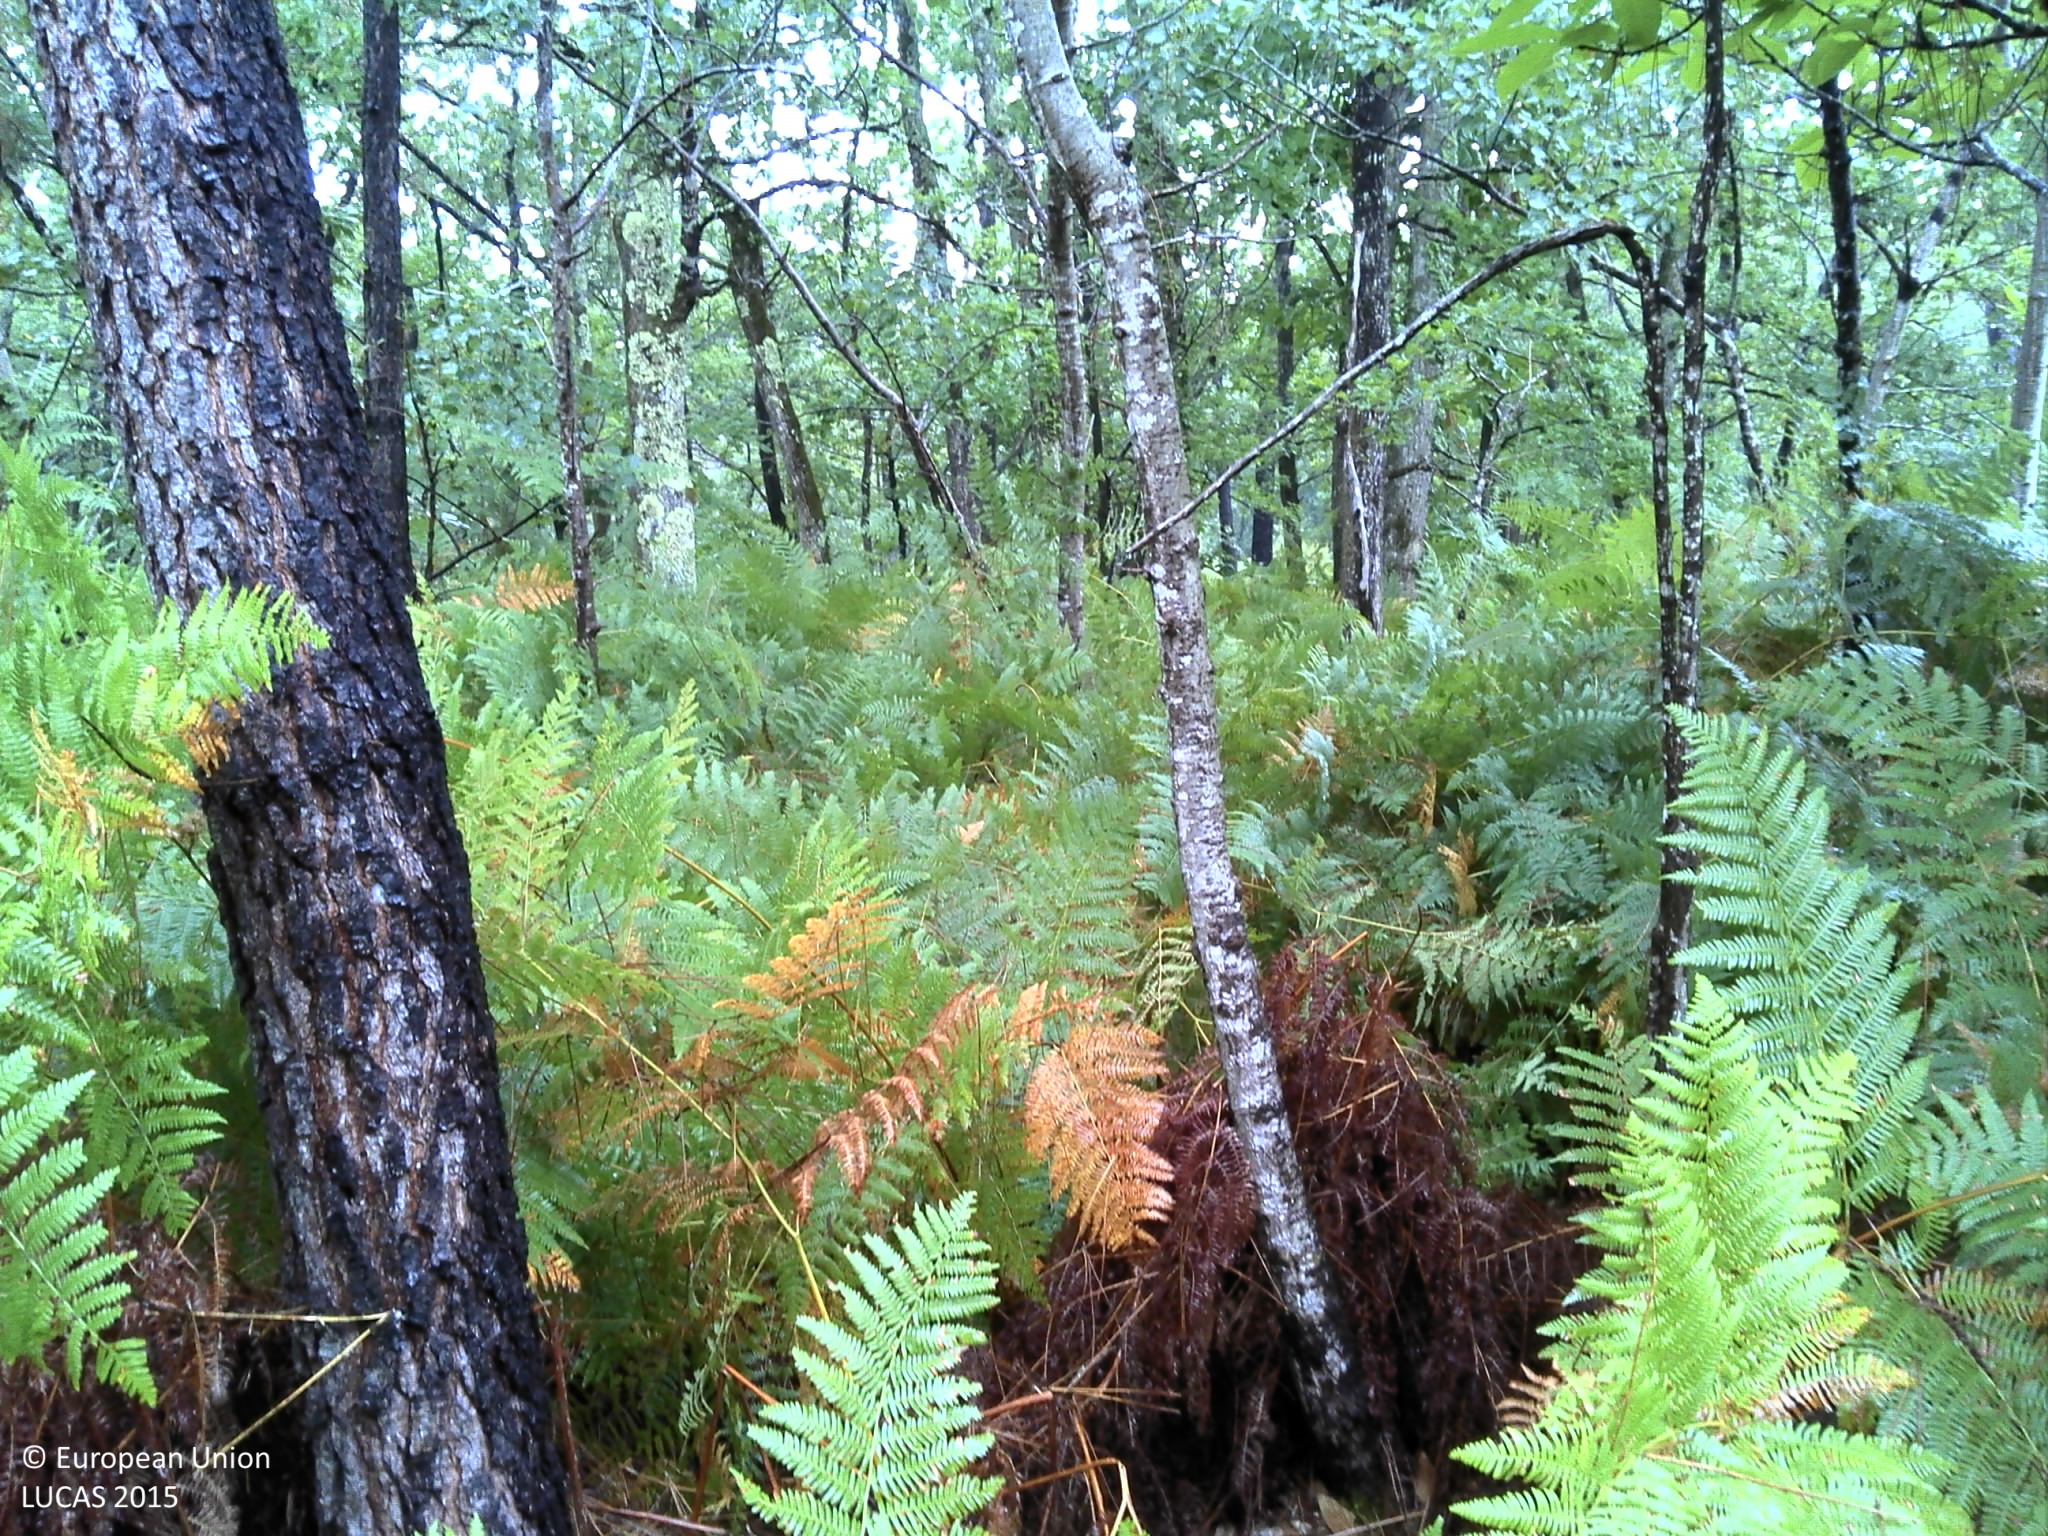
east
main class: Woodland
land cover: Pine dominated mixed woodland
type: coniferous forest of the mediterranean region
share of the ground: > 75 %
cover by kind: broadleaved forest trees 40 %, shrubs 30 %, coniferous forest trees 20 %, herbaceous plants 10 %
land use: Forestry
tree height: > 5 m
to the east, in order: Pine dominated mixed woodland; Shrubland without tree cover; Pine dominated mixed woodland
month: August
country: FR
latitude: 45.2105
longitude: -0.5503
